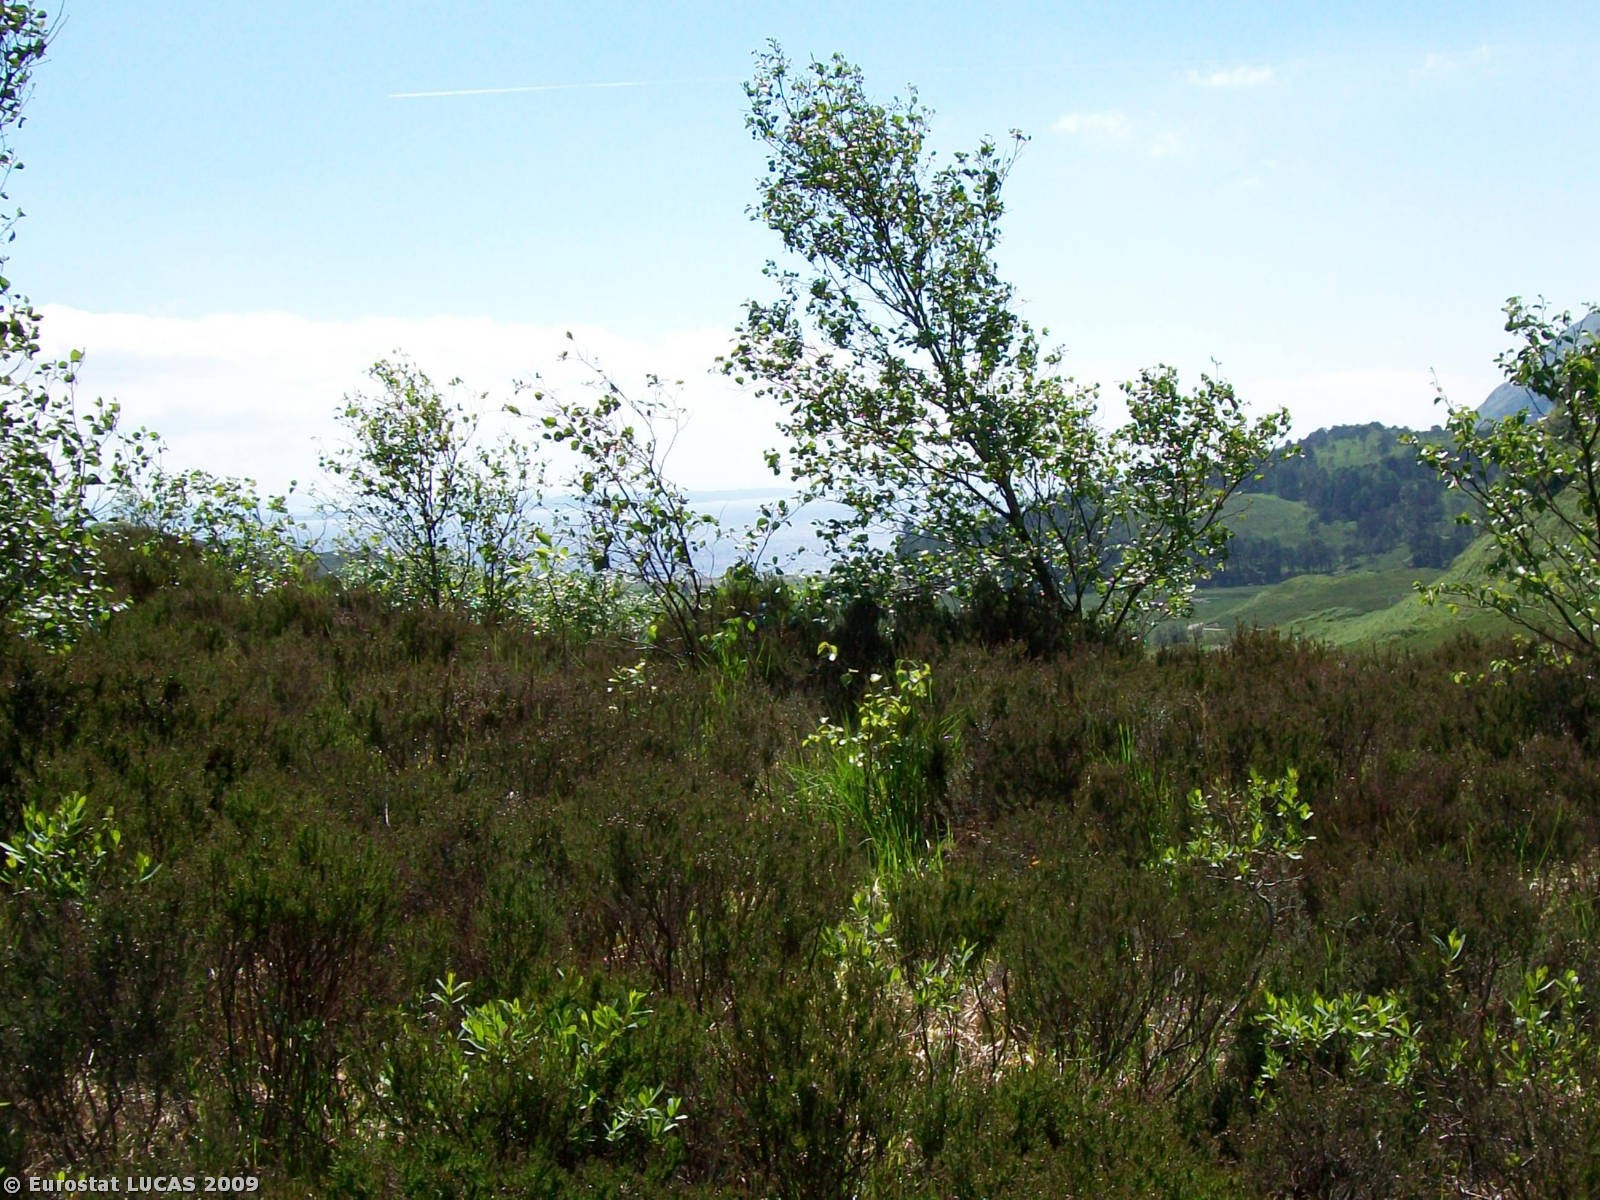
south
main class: Shrubland
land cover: Shrubland with sparse tree cover
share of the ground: > 75 %
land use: Forestry
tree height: > 5 m
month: May
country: GB
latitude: 56.6623
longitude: -5.4042
